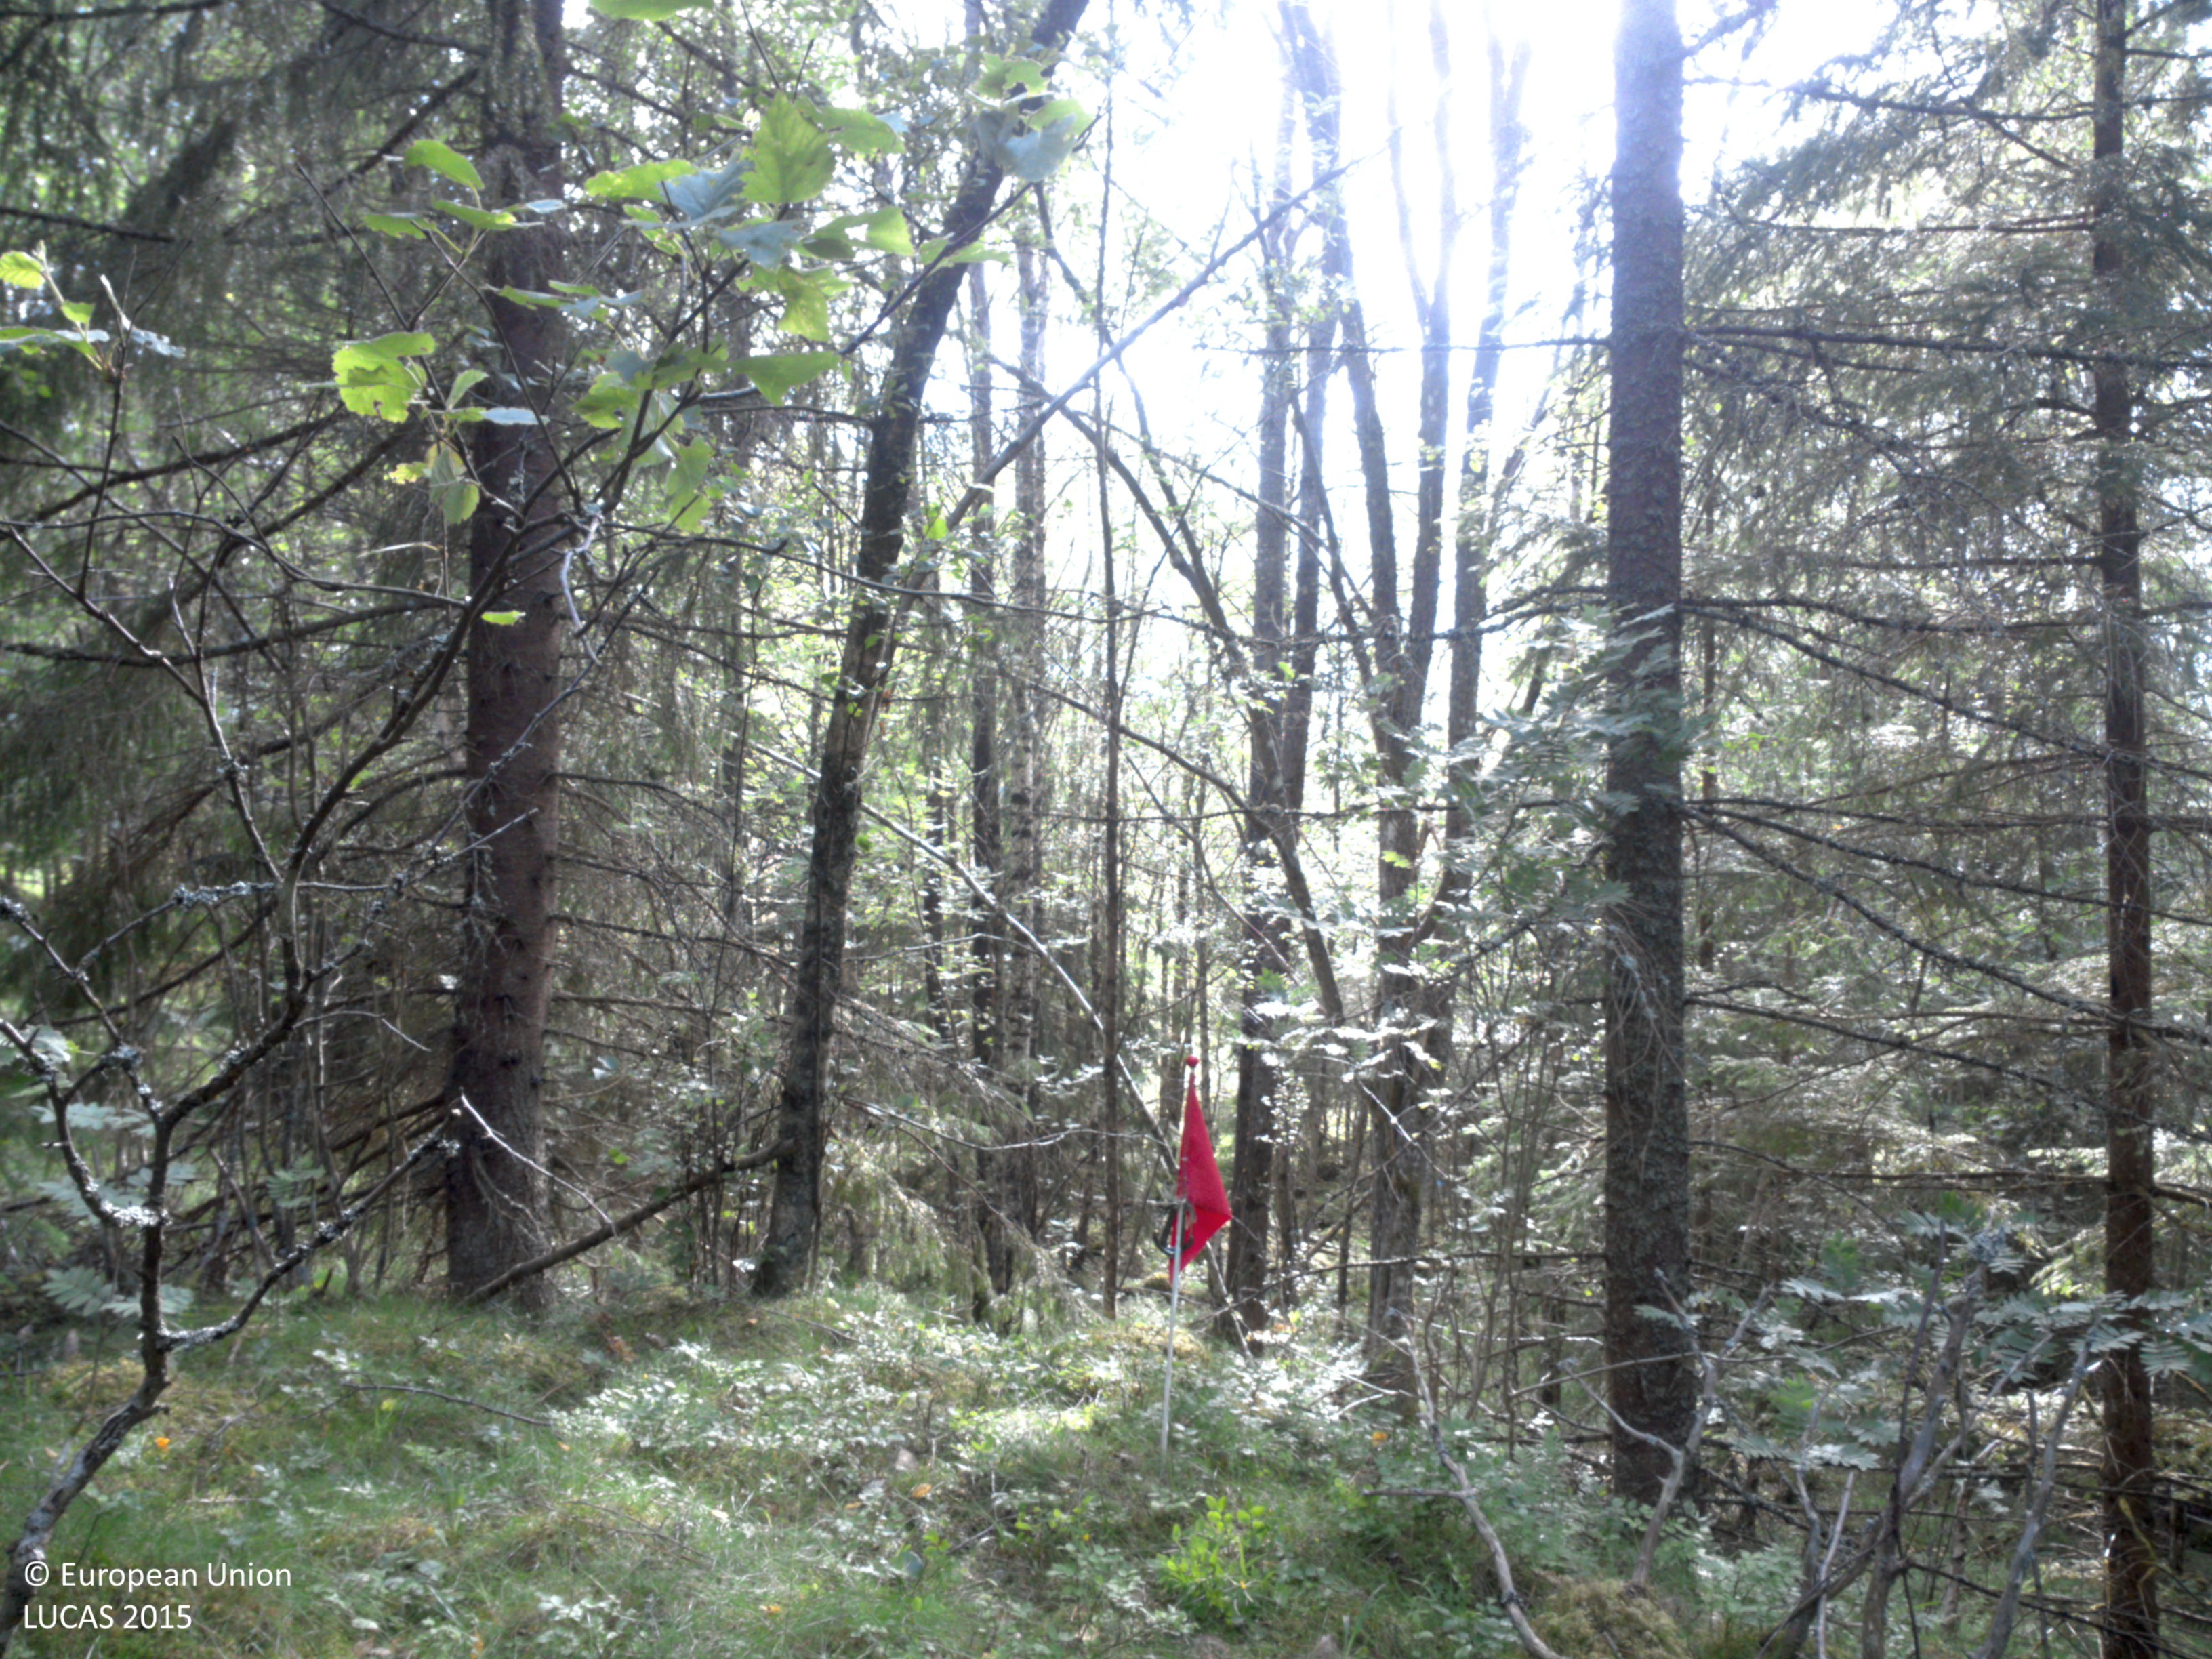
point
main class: Woodland
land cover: Spruce dominated mixed woodland
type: boreal forest
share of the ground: 50 - 75 %
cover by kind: coniferous forest trees 45 %, herbaceous plants 30 %, broadleaved forest trees 25 %
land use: Forestry
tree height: > 5 m
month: July
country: SE
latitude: 58.7441
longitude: 12.0172
